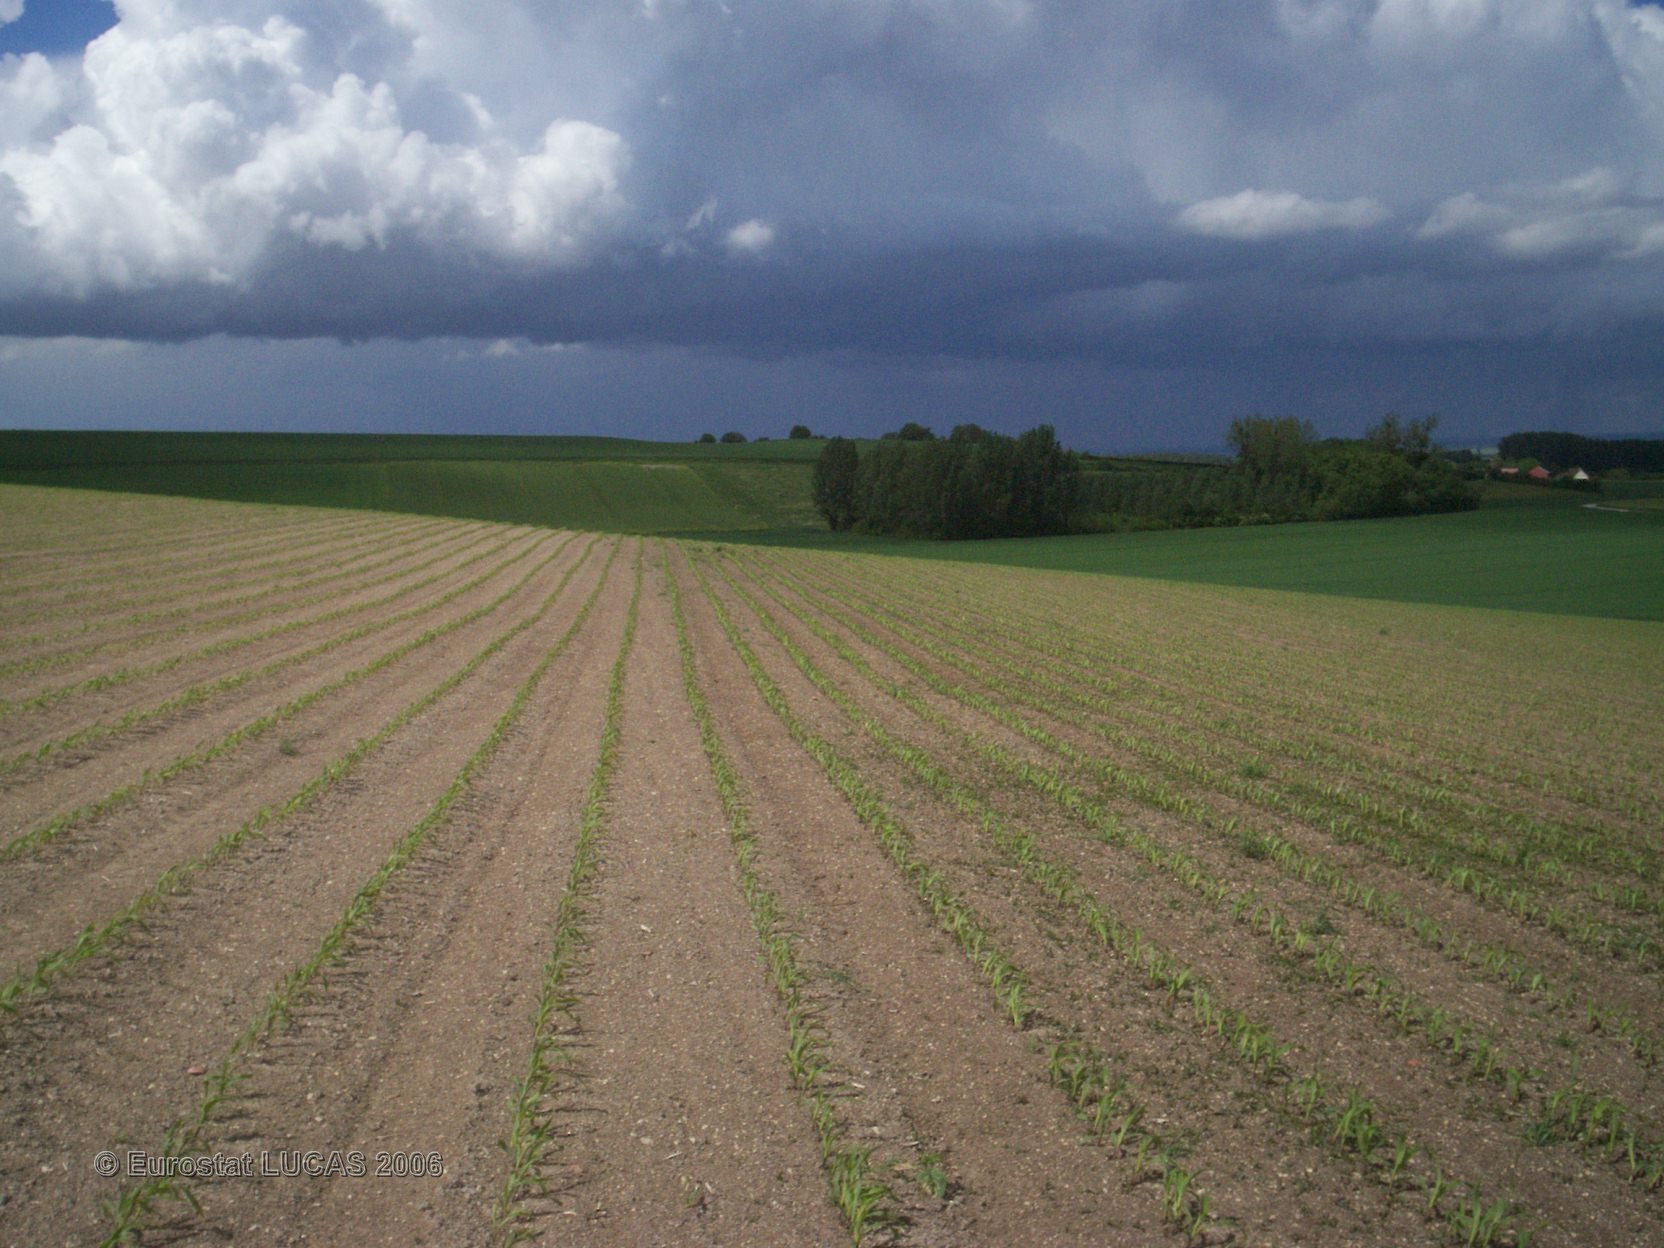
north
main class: Cropland
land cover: Maize
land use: Agriculture (excluding fallow land and kitchen gardens)
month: May
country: FR
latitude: 49.4244
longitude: 4.5784
